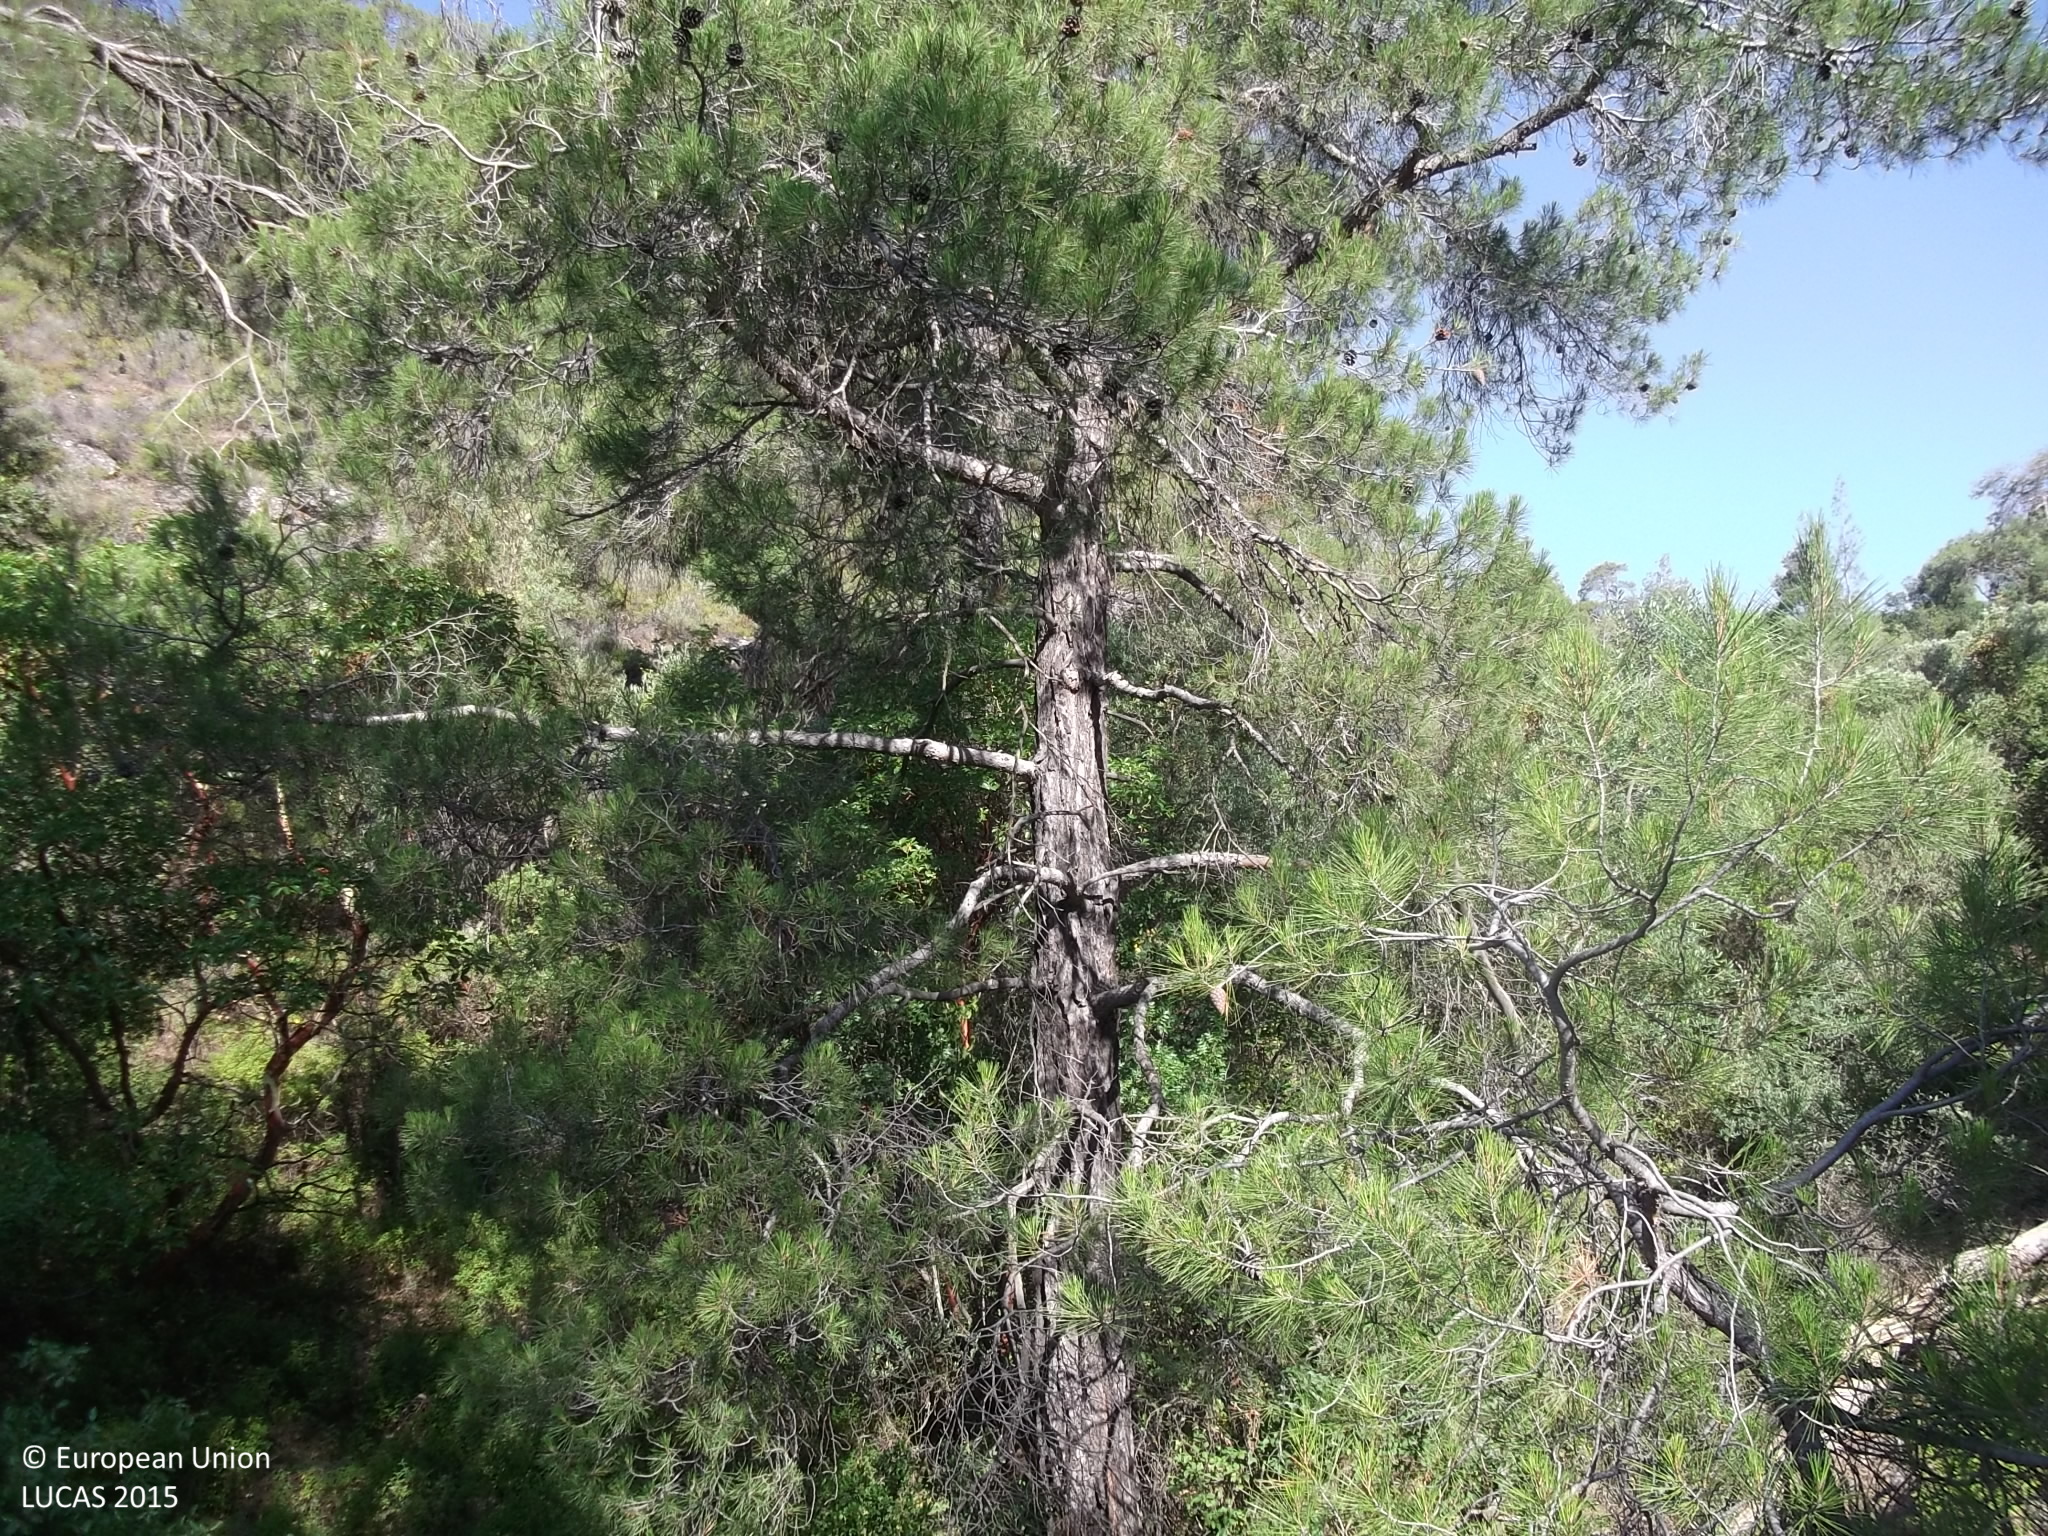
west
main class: Woodland
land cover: Pine dominated coniferous woodland
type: coniferous forest of the mediterranean region
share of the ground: 25 - 50 %
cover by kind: coniferous forest trees 45 %, shrubs 30 %, consolidated bare surface 10 %, unconsolidated bare surface 10 %, broadleaved forest trees 5 %
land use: Semi-natural and natural areas not in use
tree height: > 5 m
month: June
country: CY
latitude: 34.8397
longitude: 32.9677
